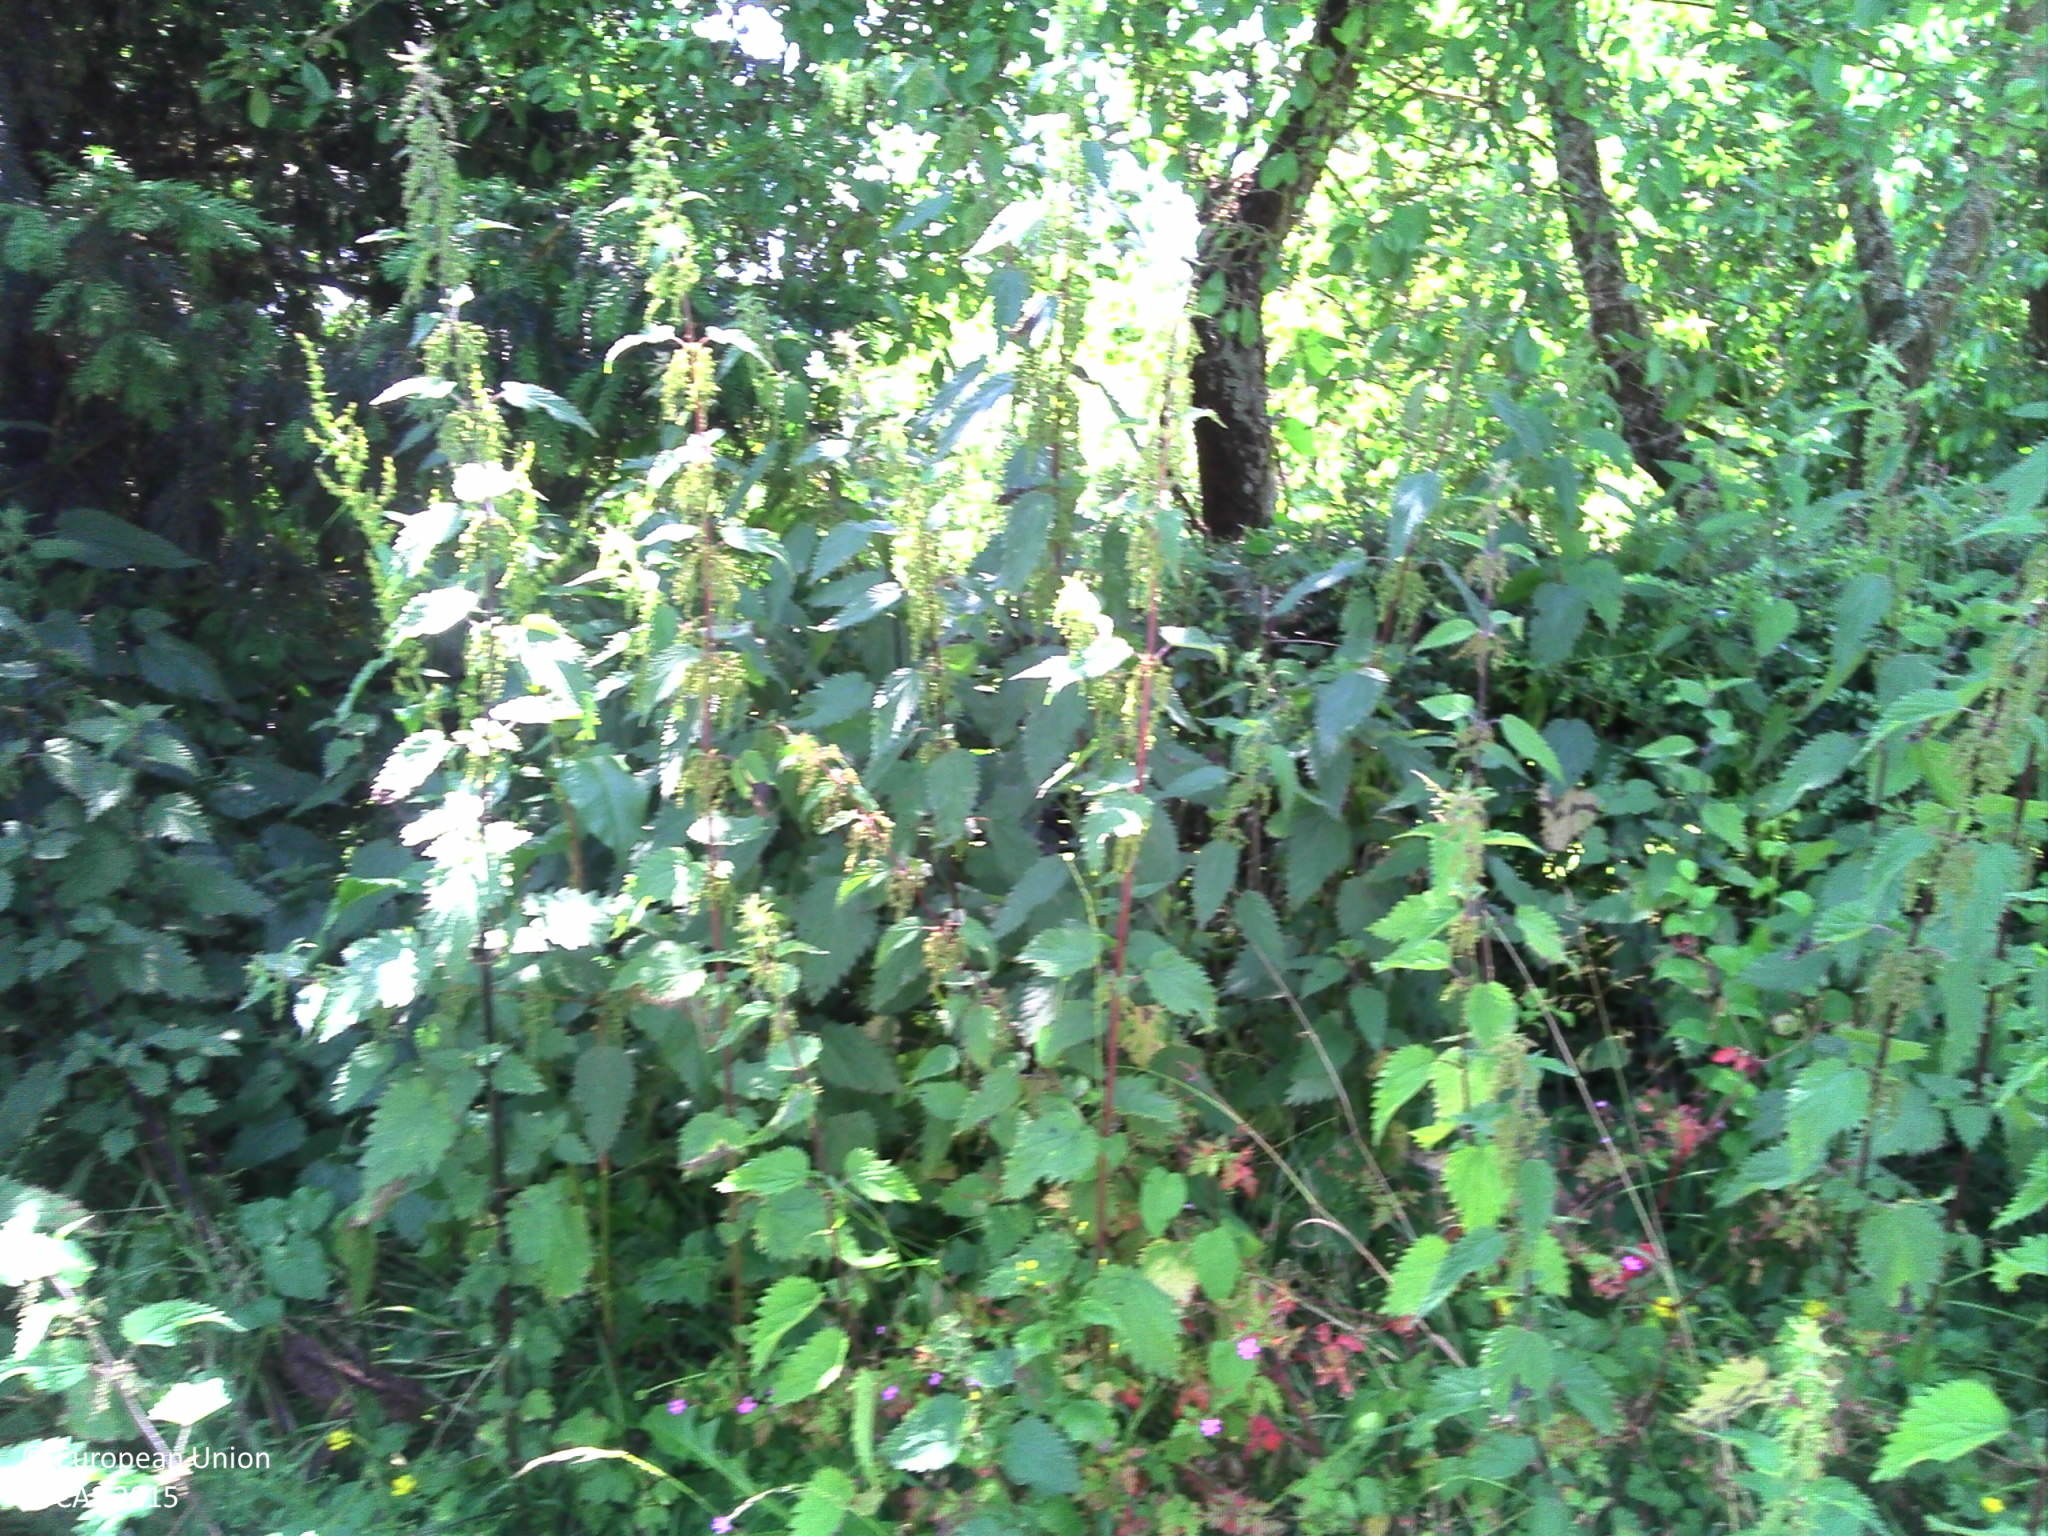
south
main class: Grassland
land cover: Grassland with sparse tree/shrub cover
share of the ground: > 75 %
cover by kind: herbaceous plants 95 %, broadleaved forest trees 5 %
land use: Residential
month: June
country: FR
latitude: 48.0427
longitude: -1.6229
